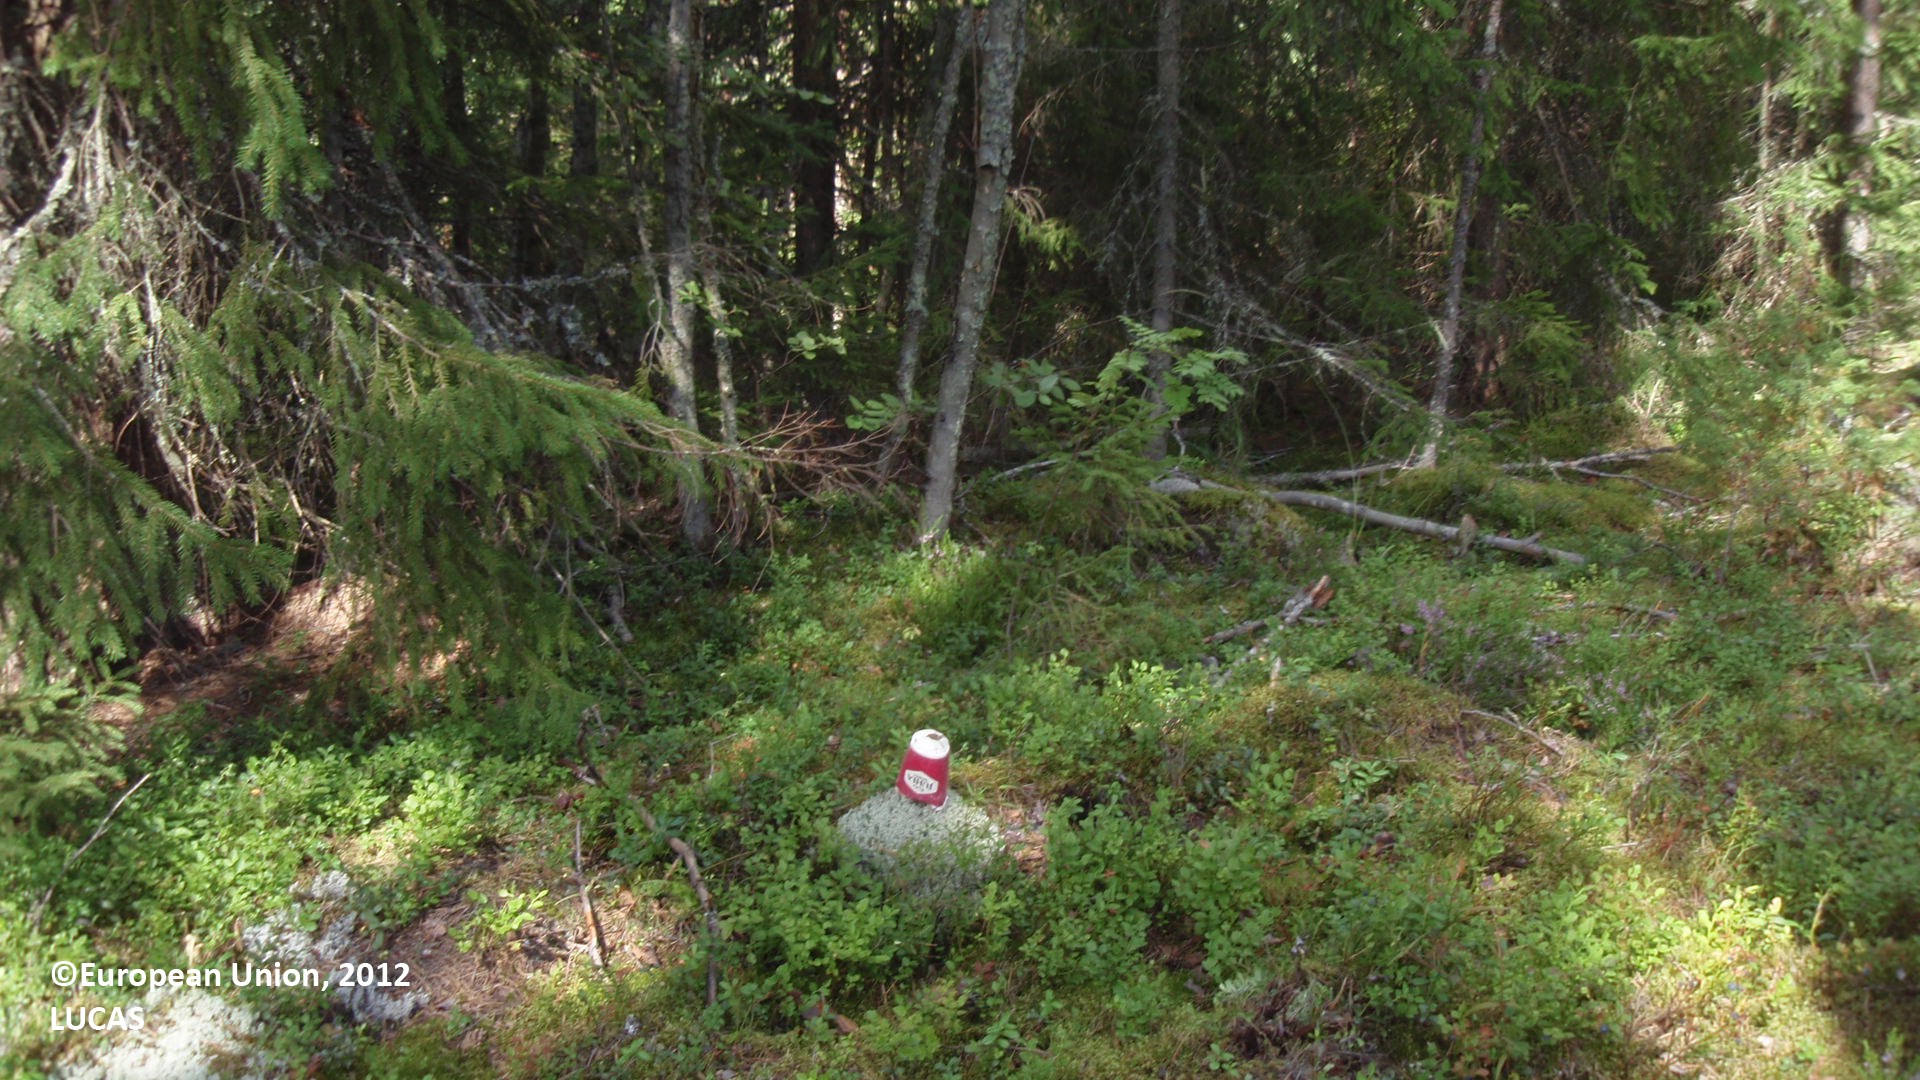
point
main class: Woodland
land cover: Pine dominated coniferous woodland
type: boreal forest
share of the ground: 50 - 75 %
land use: Forestry
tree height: > 5 m
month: August
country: FI
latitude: 61.1539
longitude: 27.7478
